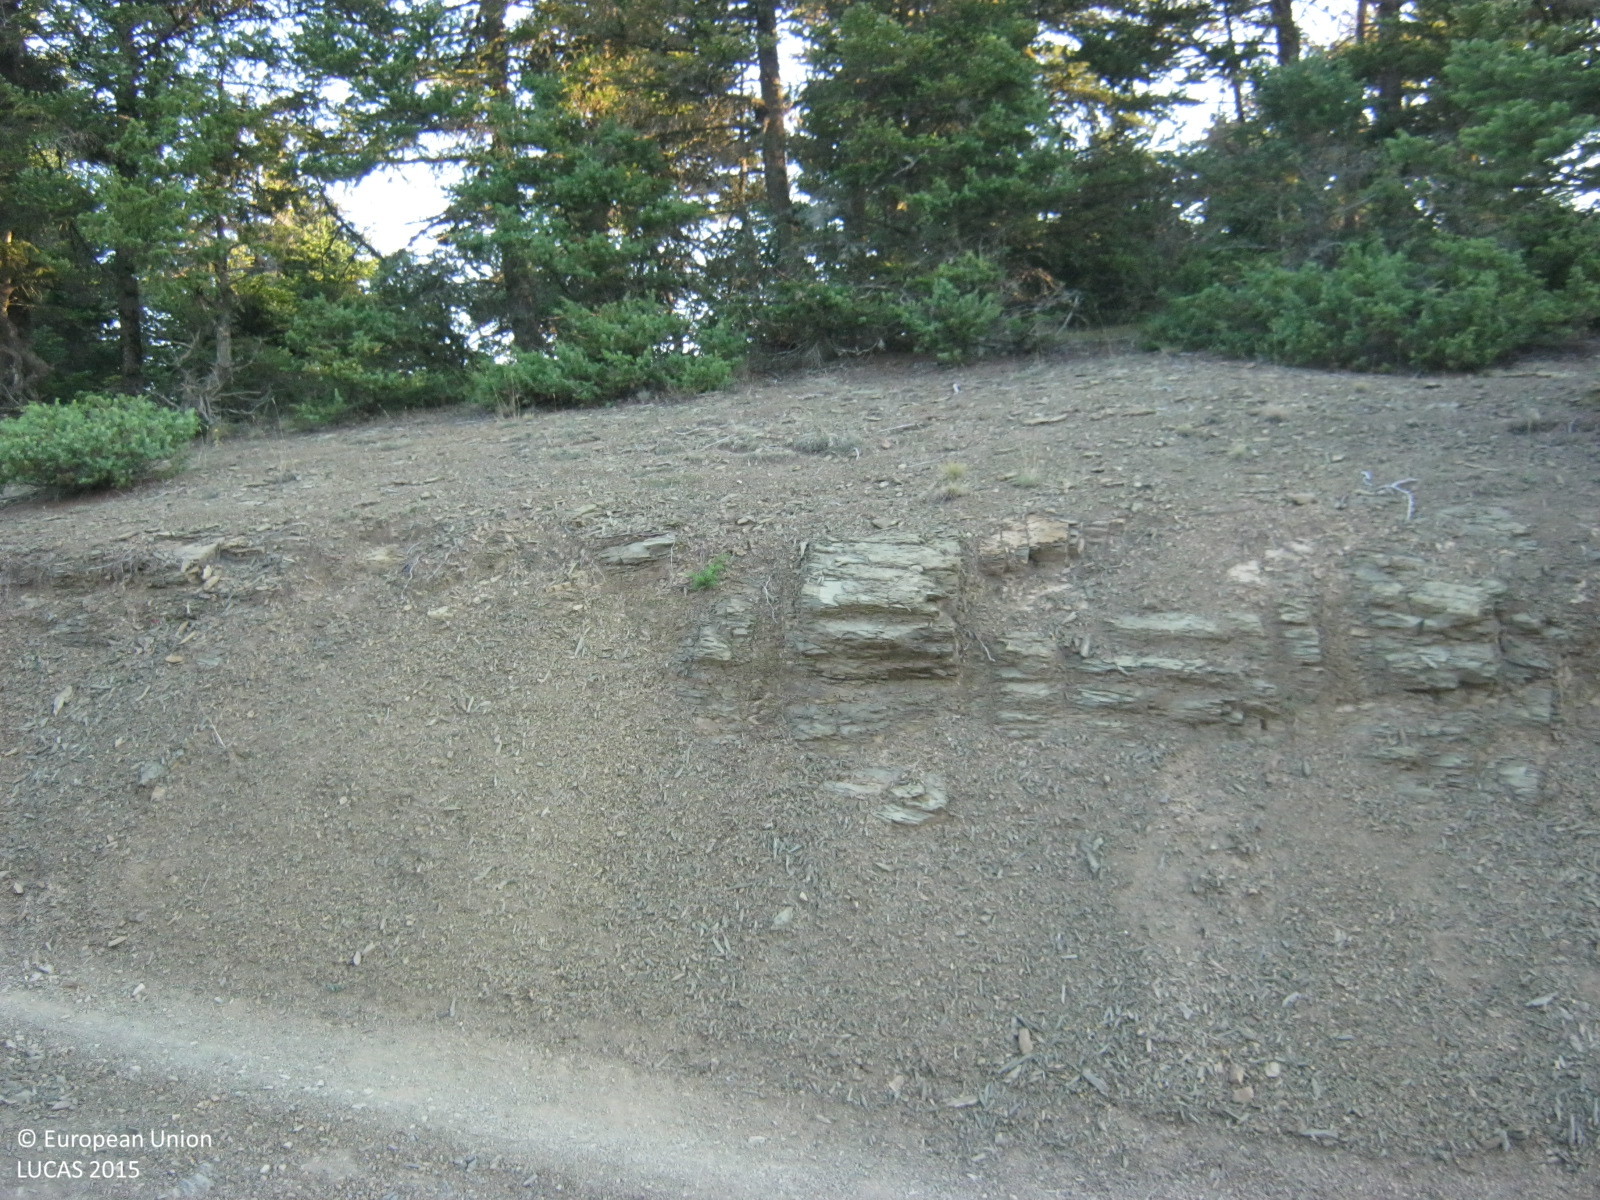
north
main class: Woodland
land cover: Spruce dominated coniferous woodland
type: coniferous forest of the mediterranean region
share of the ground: > 75 %
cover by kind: coniferous forest trees 80 %, herbaceous plants 10 %, unconsolidated bare surface 10 %
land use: Forestry
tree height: > 5 m
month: August
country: GR
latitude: 37.6909
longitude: 22.0626
